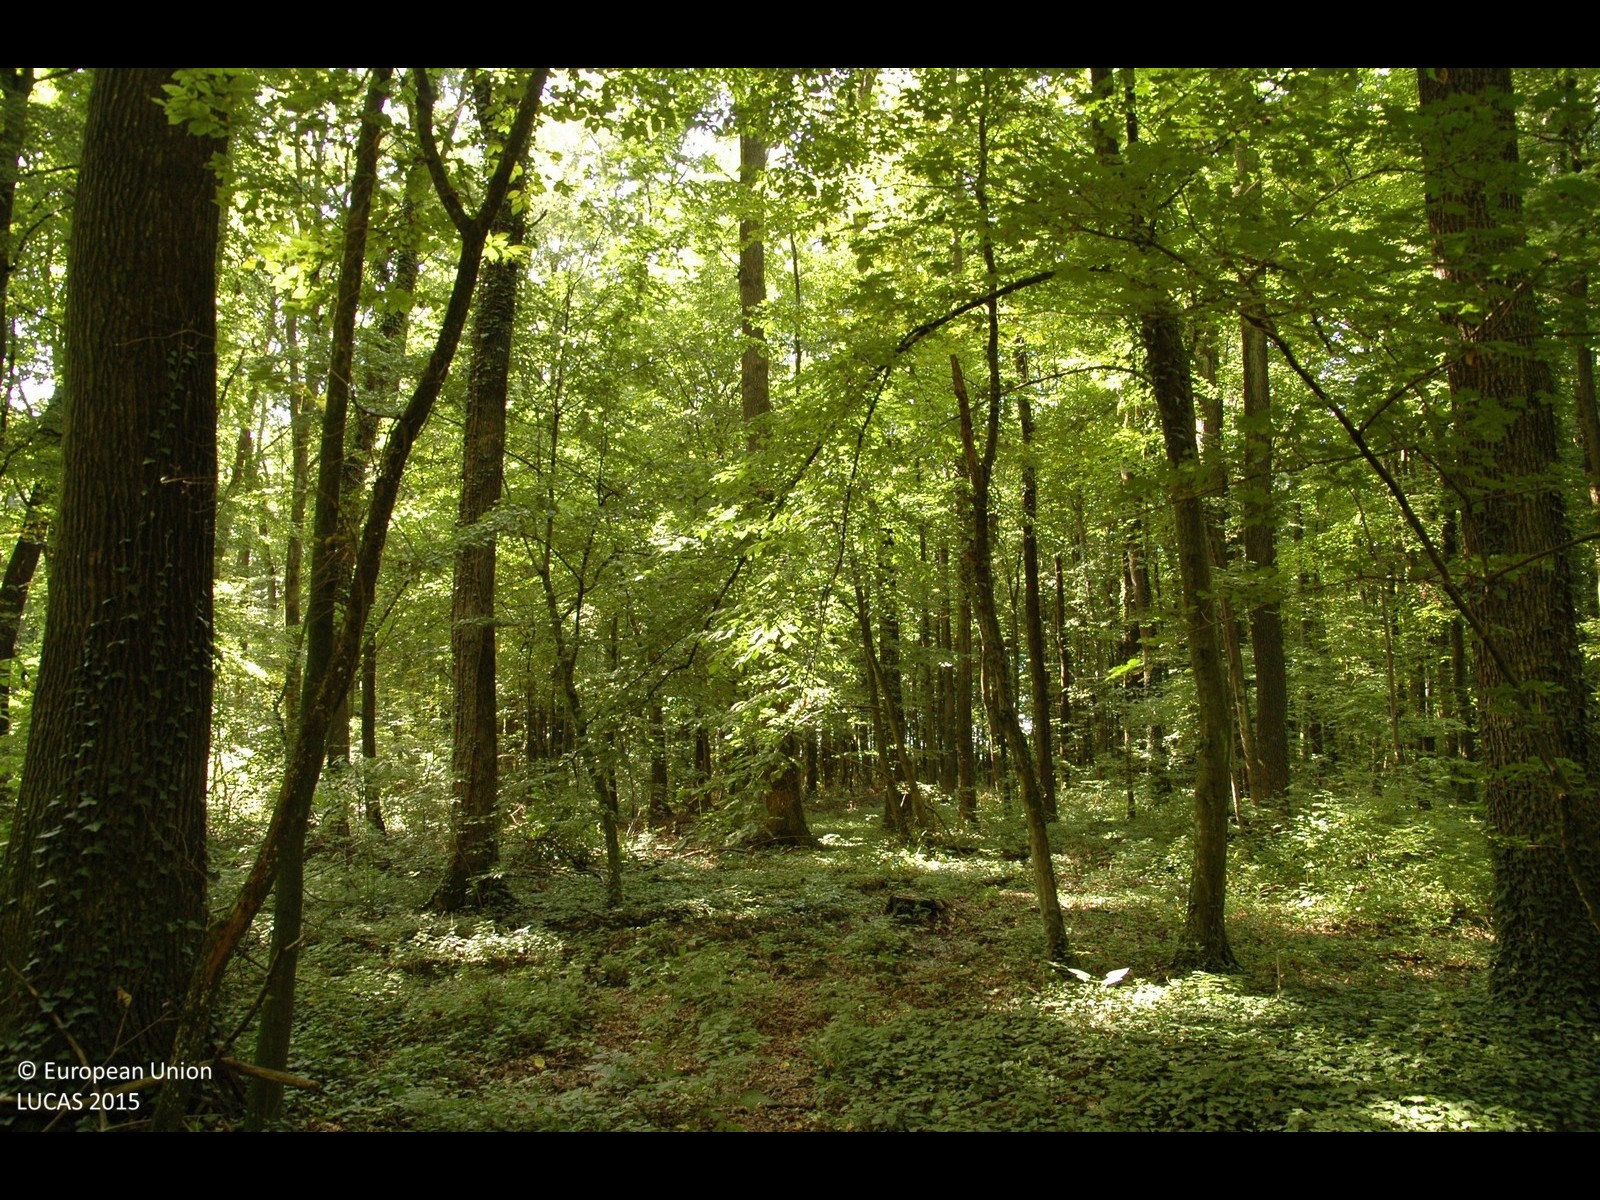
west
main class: Woodland
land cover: Broadleaved woodland
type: mesophytic deciduous forest
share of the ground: > 75 %
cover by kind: broadleaved forest trees 100 %
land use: Forestry
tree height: > 5 m
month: August
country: HR
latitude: 46.1479
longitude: 16.8762
